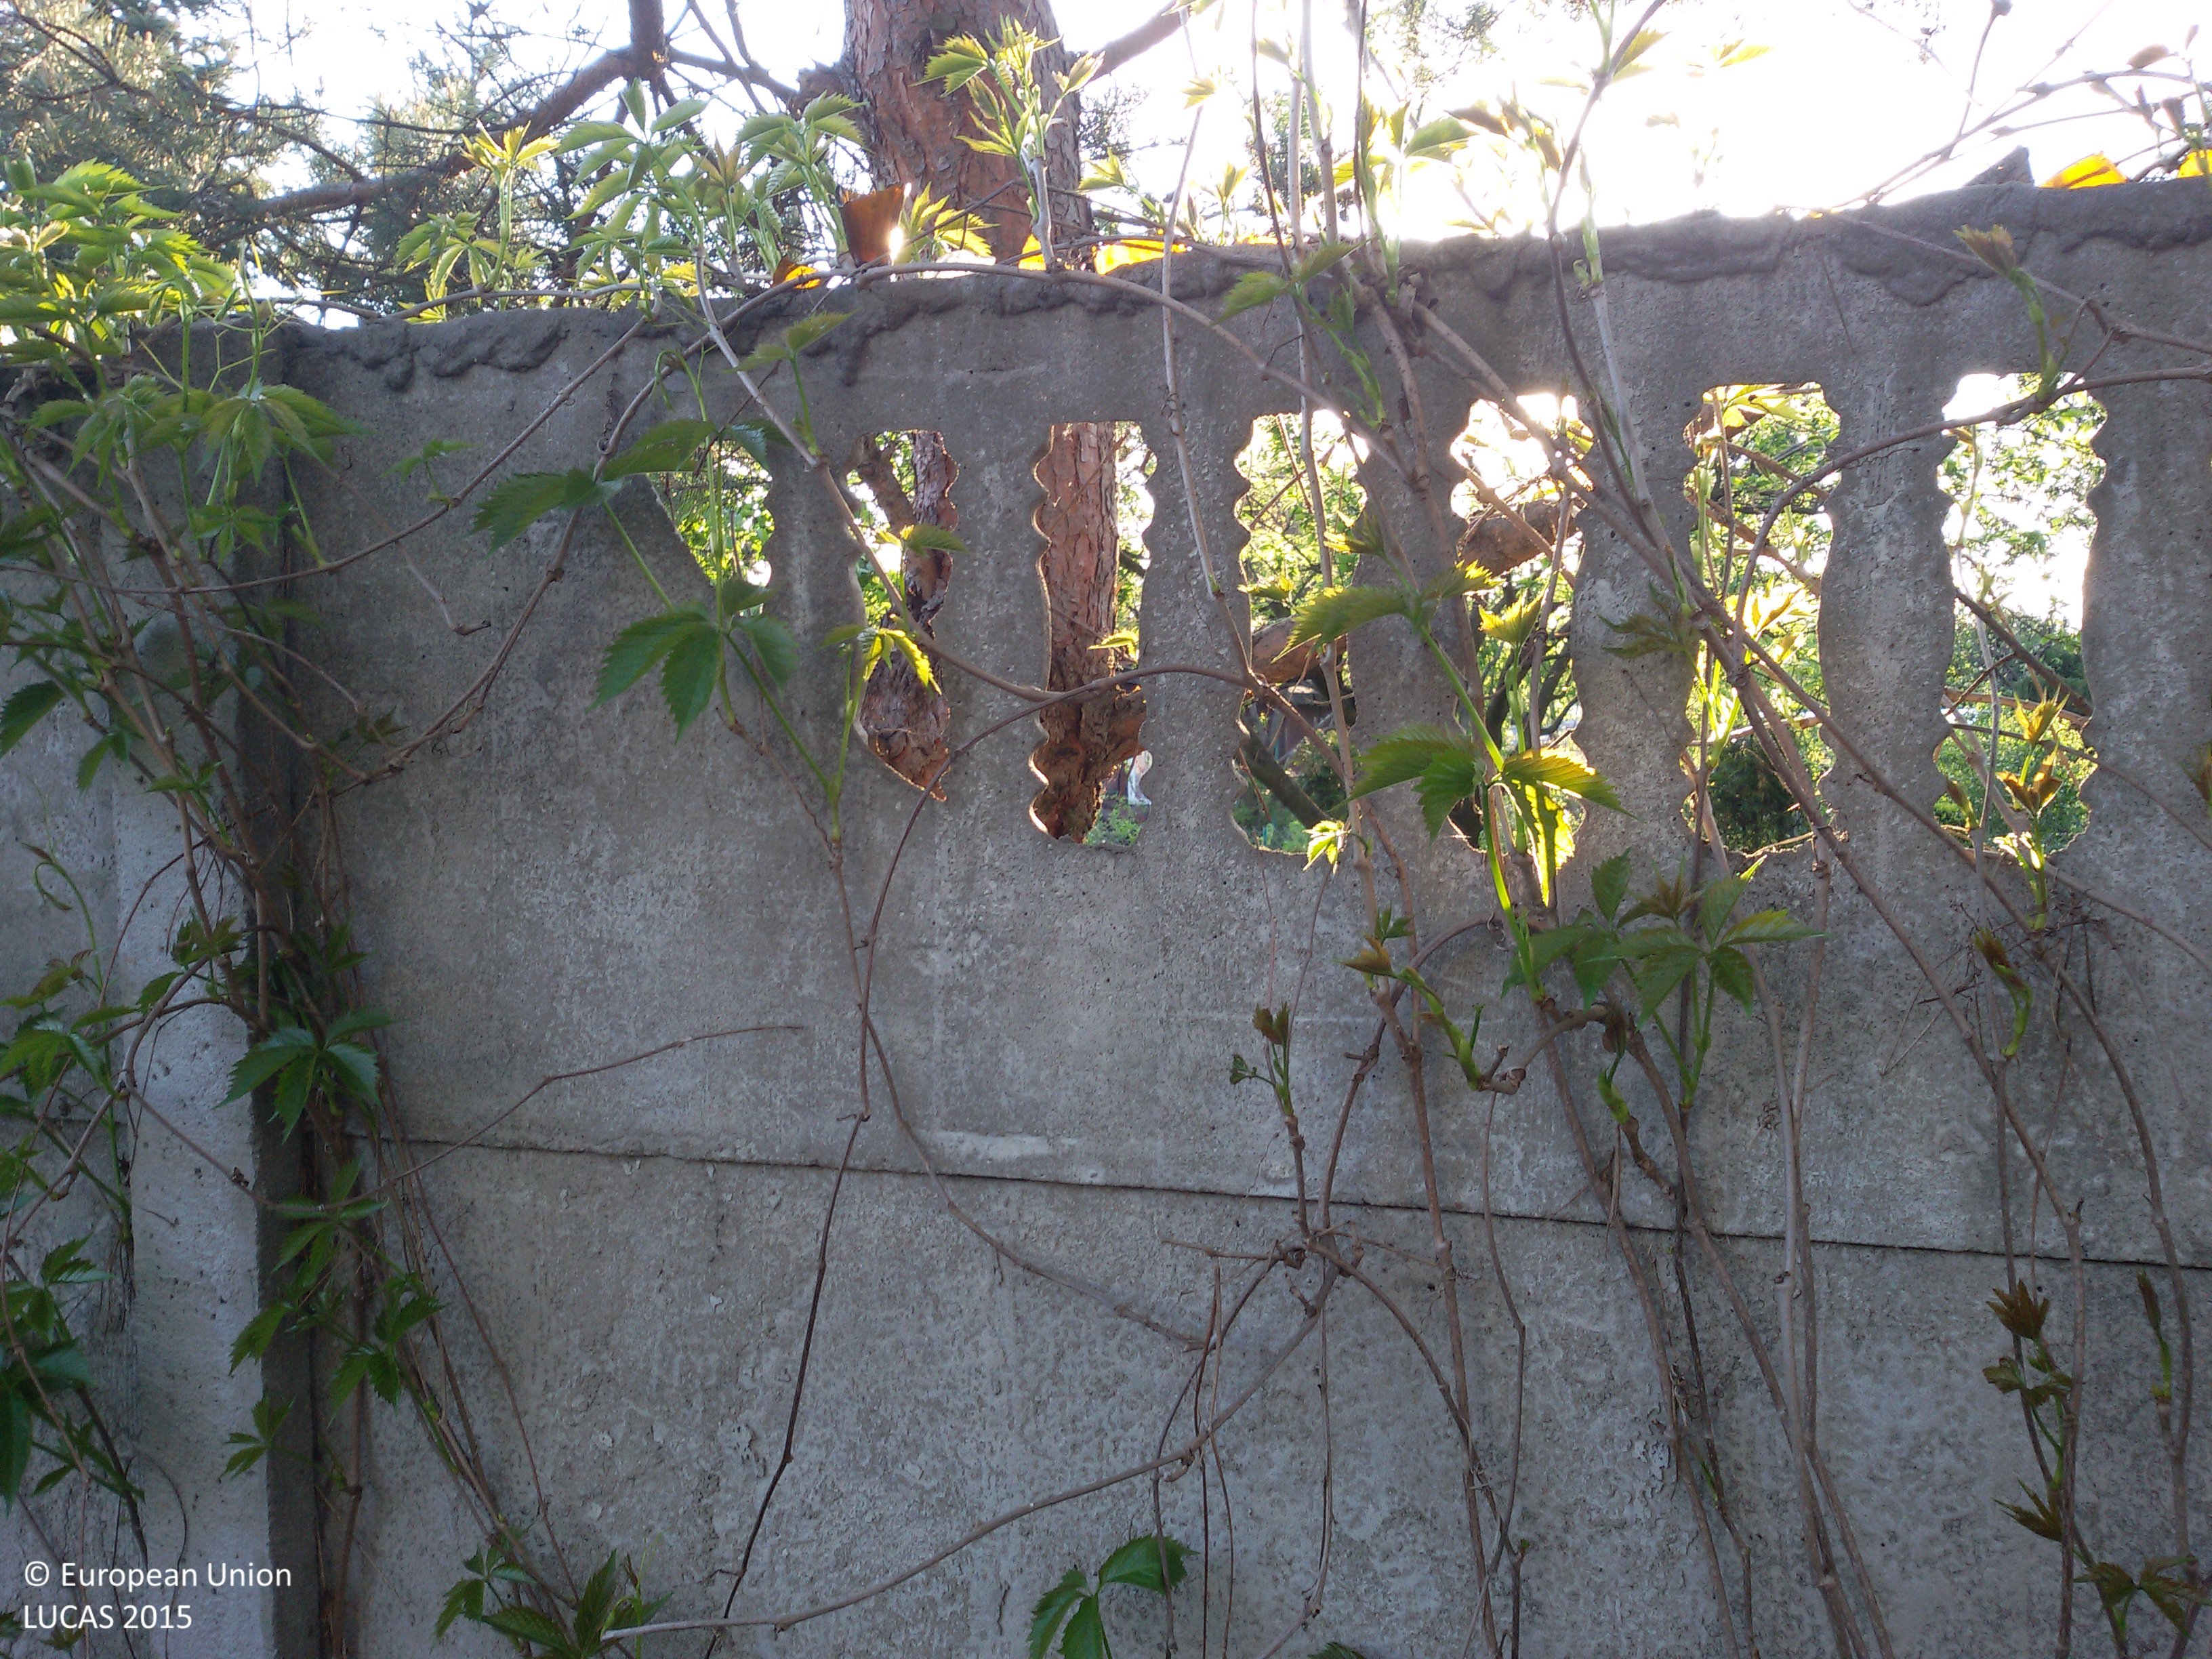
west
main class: Woodland
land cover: Broadleaved woodland
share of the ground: 50 - 75 %
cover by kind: broadleaved forest trees 50 %, herbaceous plants 50 %
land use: Amenities, museums, leisure
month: May
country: PL
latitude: 52.1745
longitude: 20.7895
